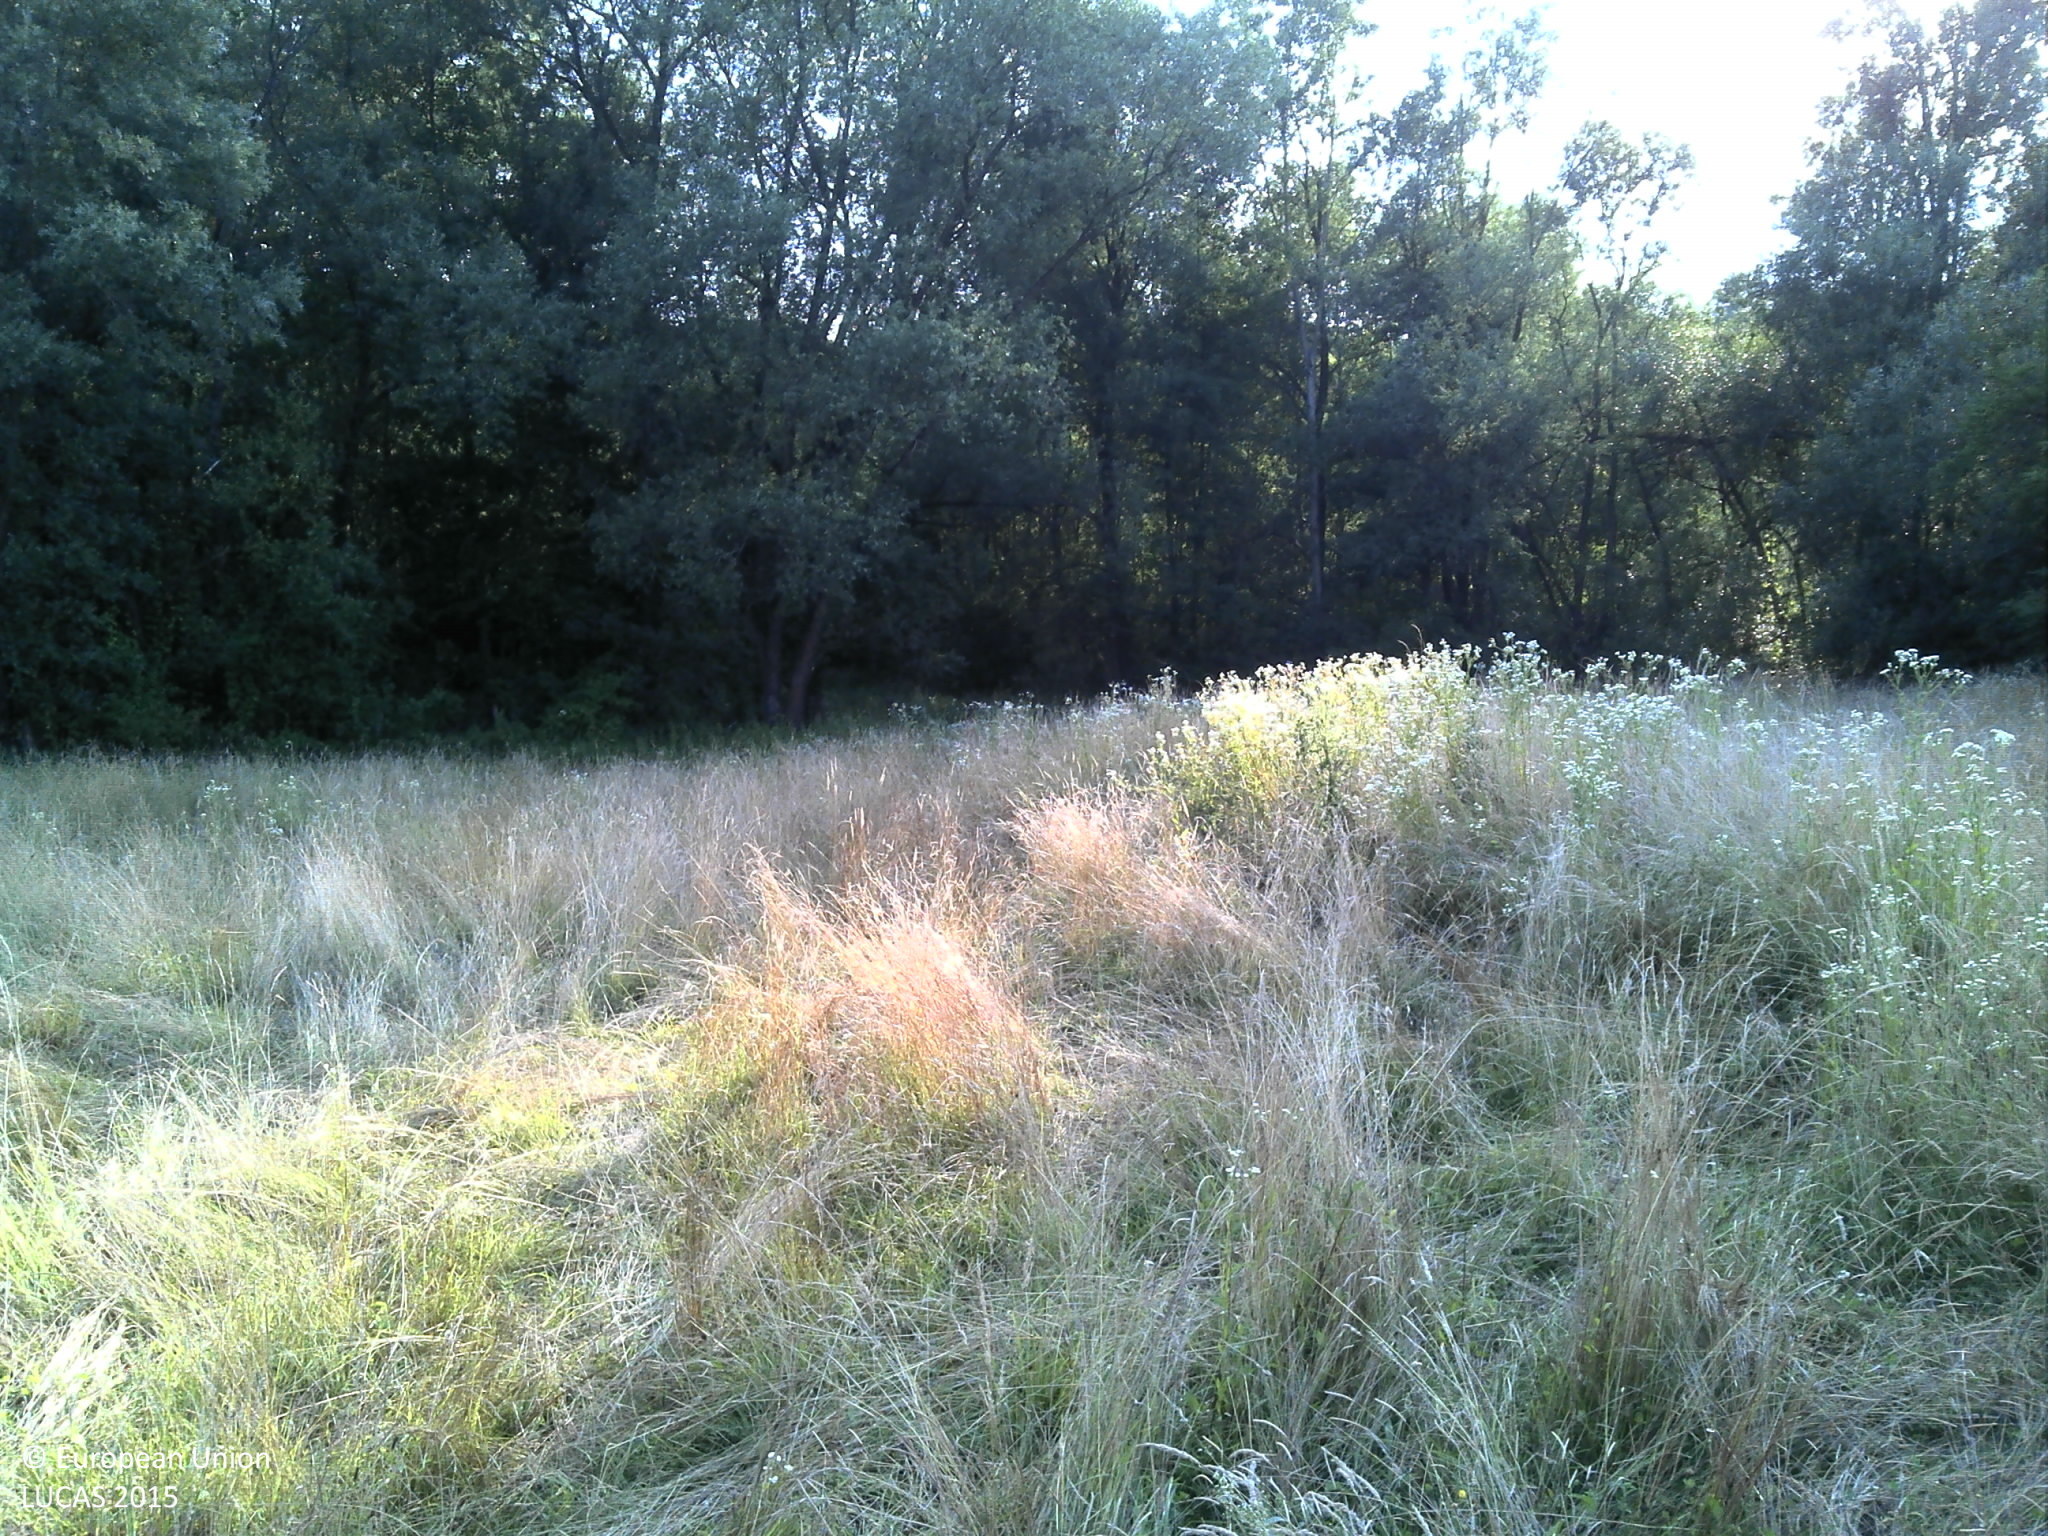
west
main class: Grassland
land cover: Grassland without tree/shrub cover
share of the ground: > 75 %
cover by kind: herbaceous plants 100 %
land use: Semi-natural and natural areas not in use
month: July
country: HR
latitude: 45.5431
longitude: 16.7229
